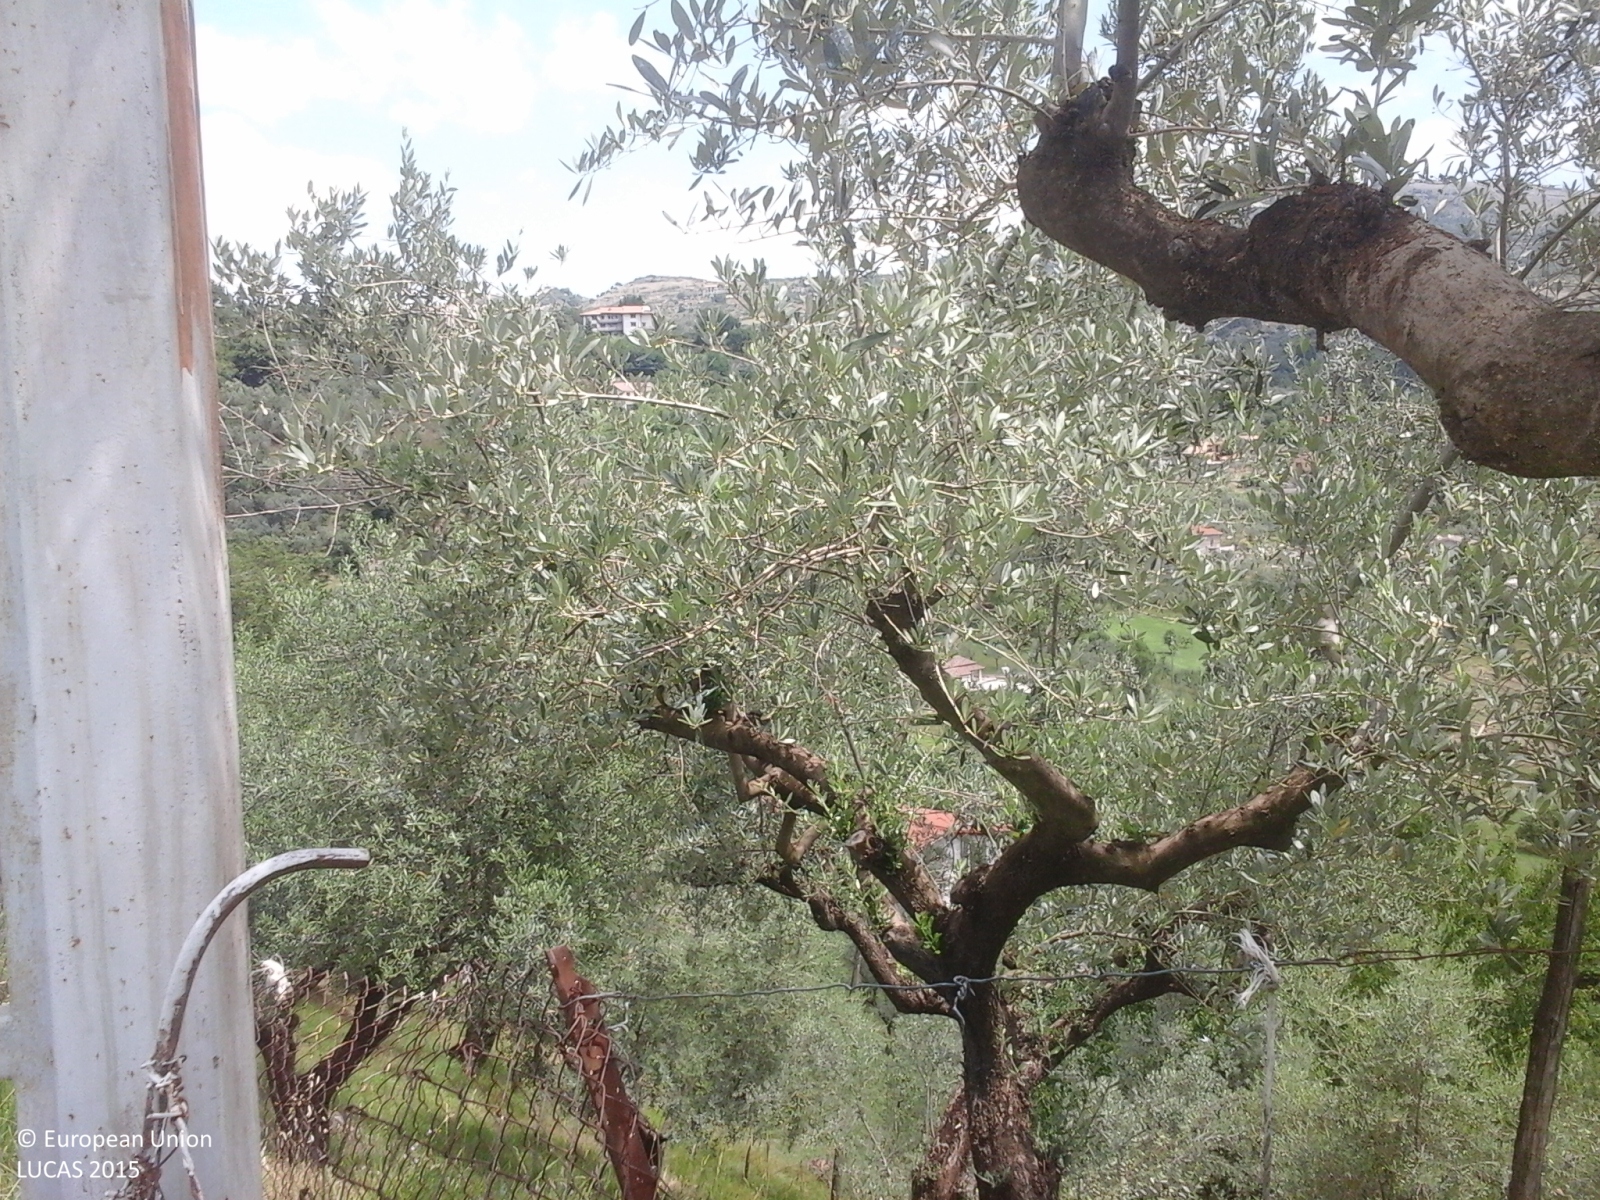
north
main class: Cropland
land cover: Olive groves
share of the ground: 50 - 75 %
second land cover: Grassland without tree/shrub cover
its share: > 75 %
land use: Agriculture (excluding fallow land and kitchen gardens)
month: June
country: IT
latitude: 41.7364
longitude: 13.1743
